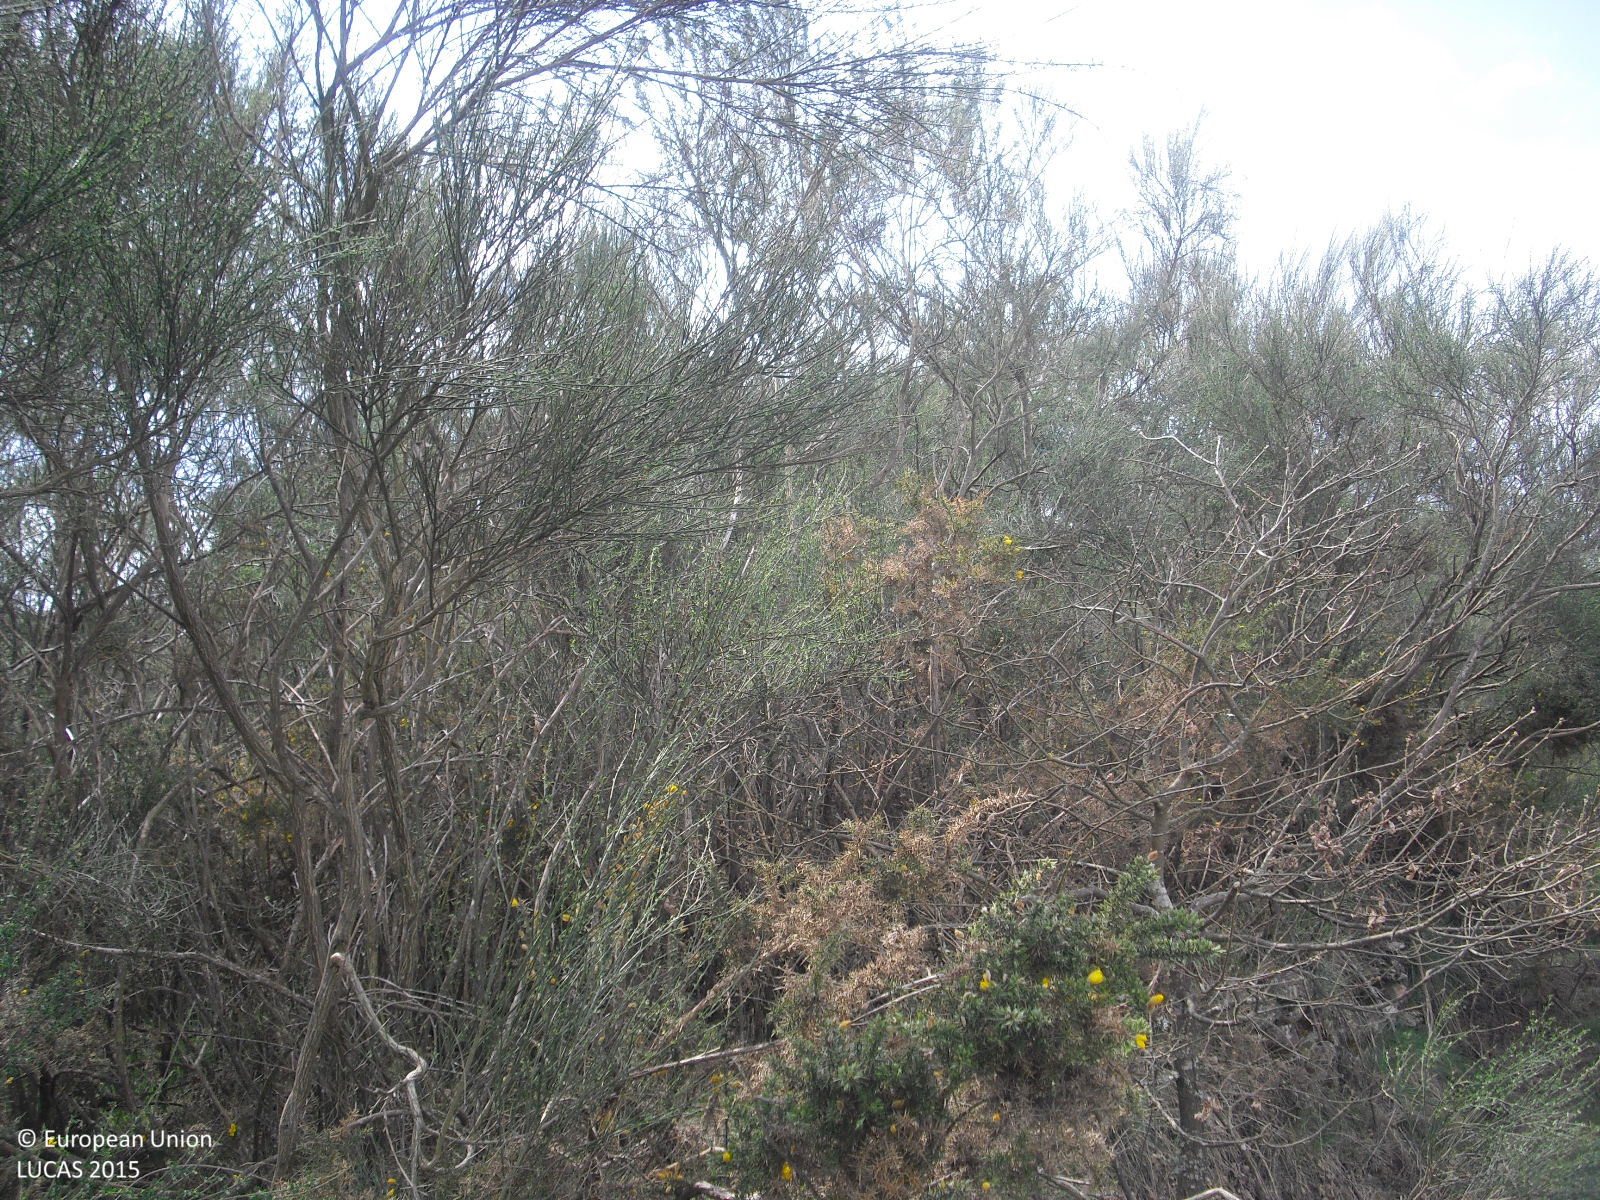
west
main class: Shrubland
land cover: Shrubland without tree cover
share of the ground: > 75 %
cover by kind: shrubs 90 %, herbaceous plants 10 %
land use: Semi-natural and natural areas not in use
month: April
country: ES
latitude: 41.9846
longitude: -7.8011
